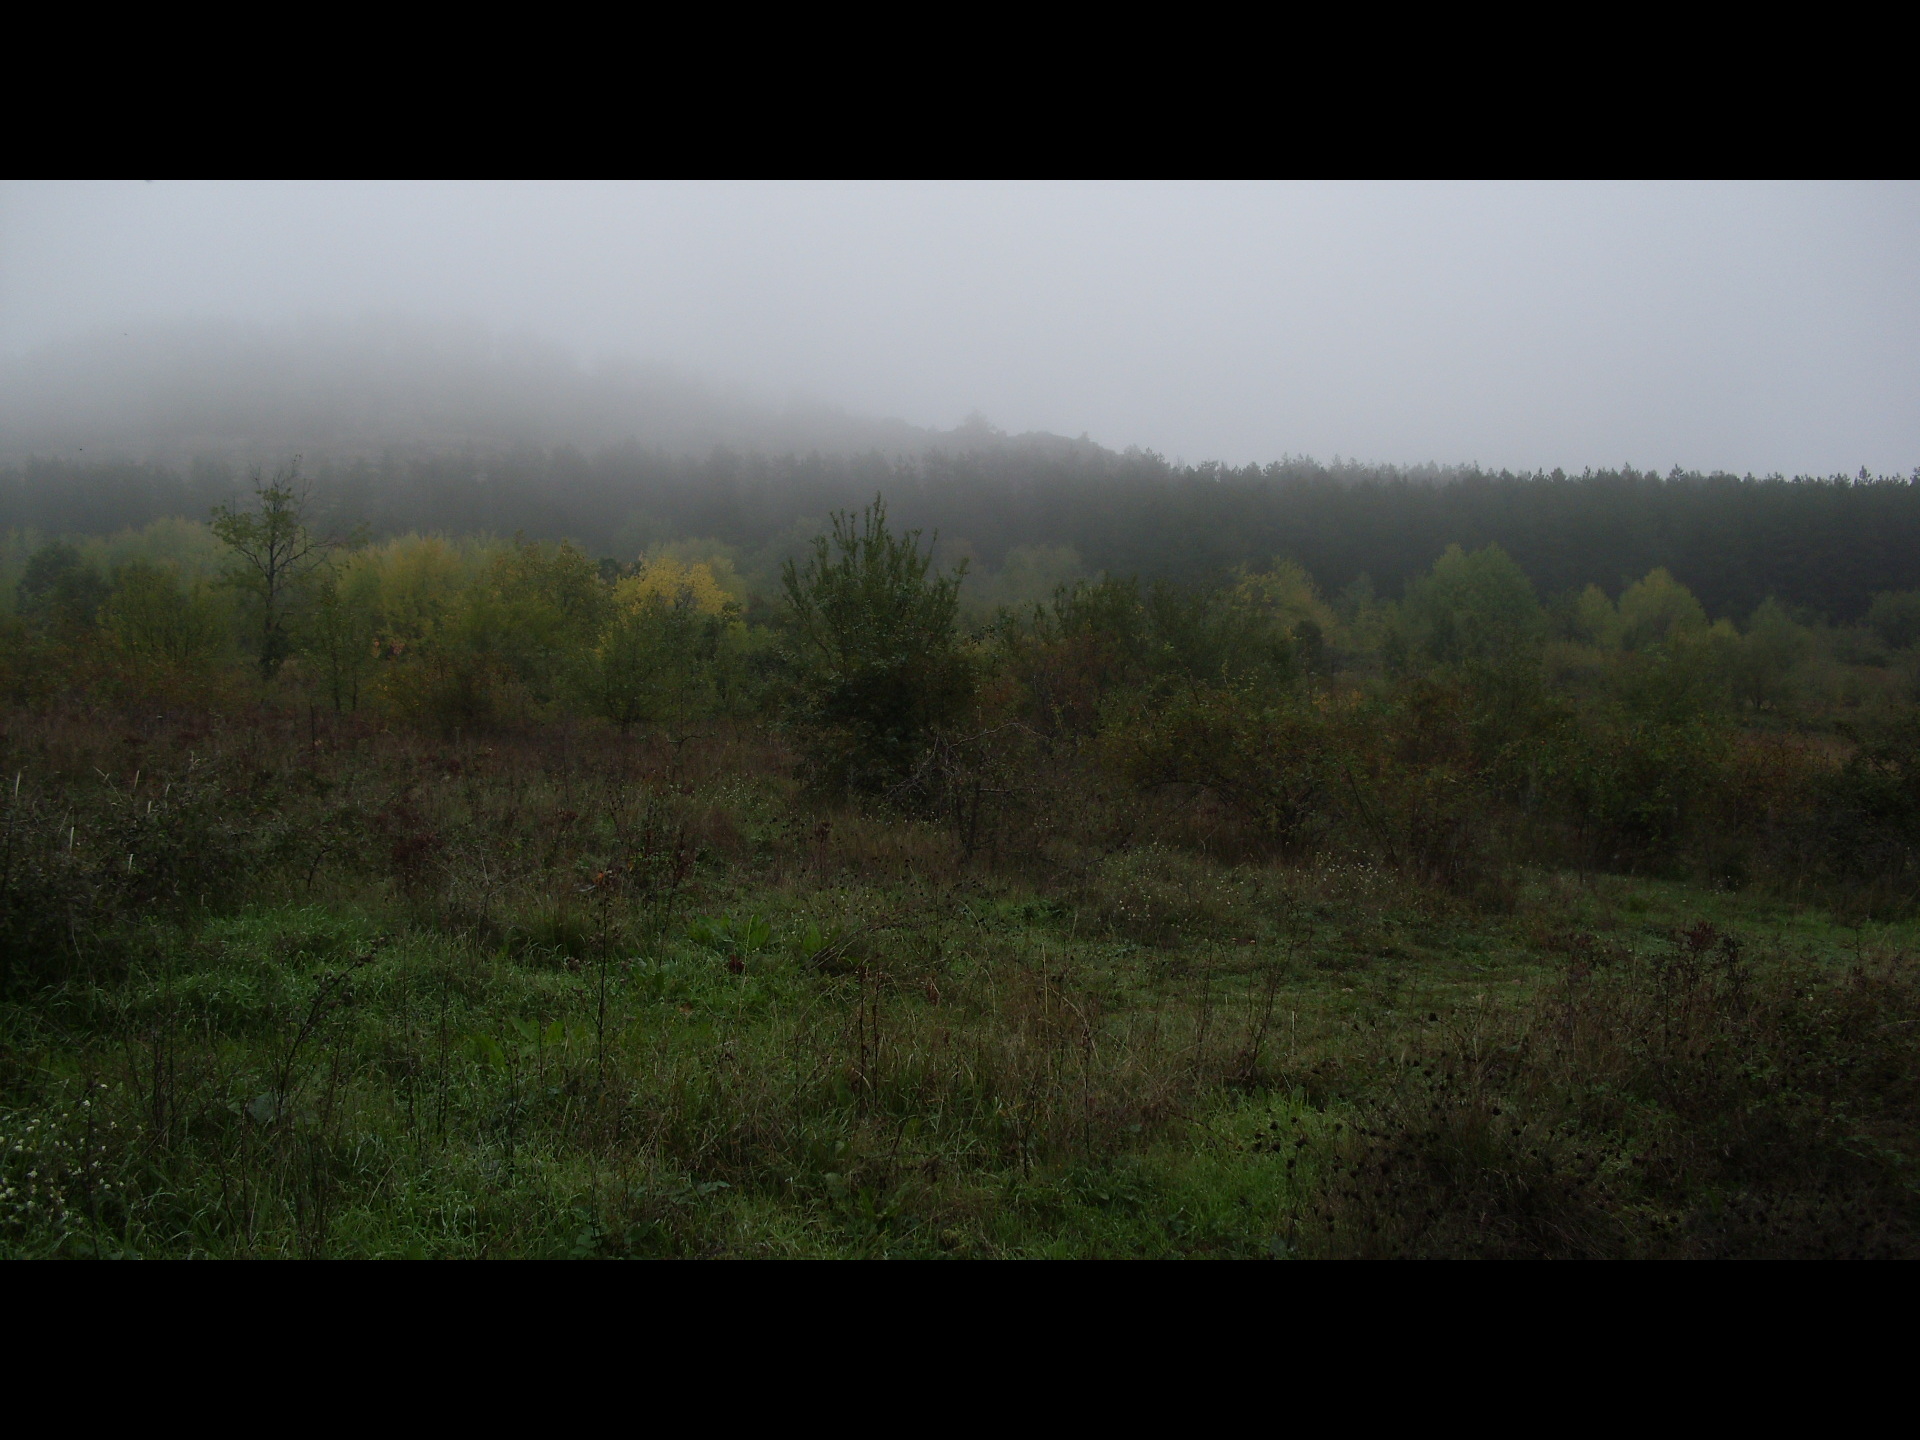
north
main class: Grassland
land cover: Grassland with sparse tree/shrub cover
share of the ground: > 75 %
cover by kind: herbaceous plants 90 %, broadleaved forest trees 5 %, shrubs 5 %
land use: Semi-natural and natural areas not in use
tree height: < 5 m
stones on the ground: < 10 %
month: October
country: BG
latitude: 43.5631
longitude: 22.8744
